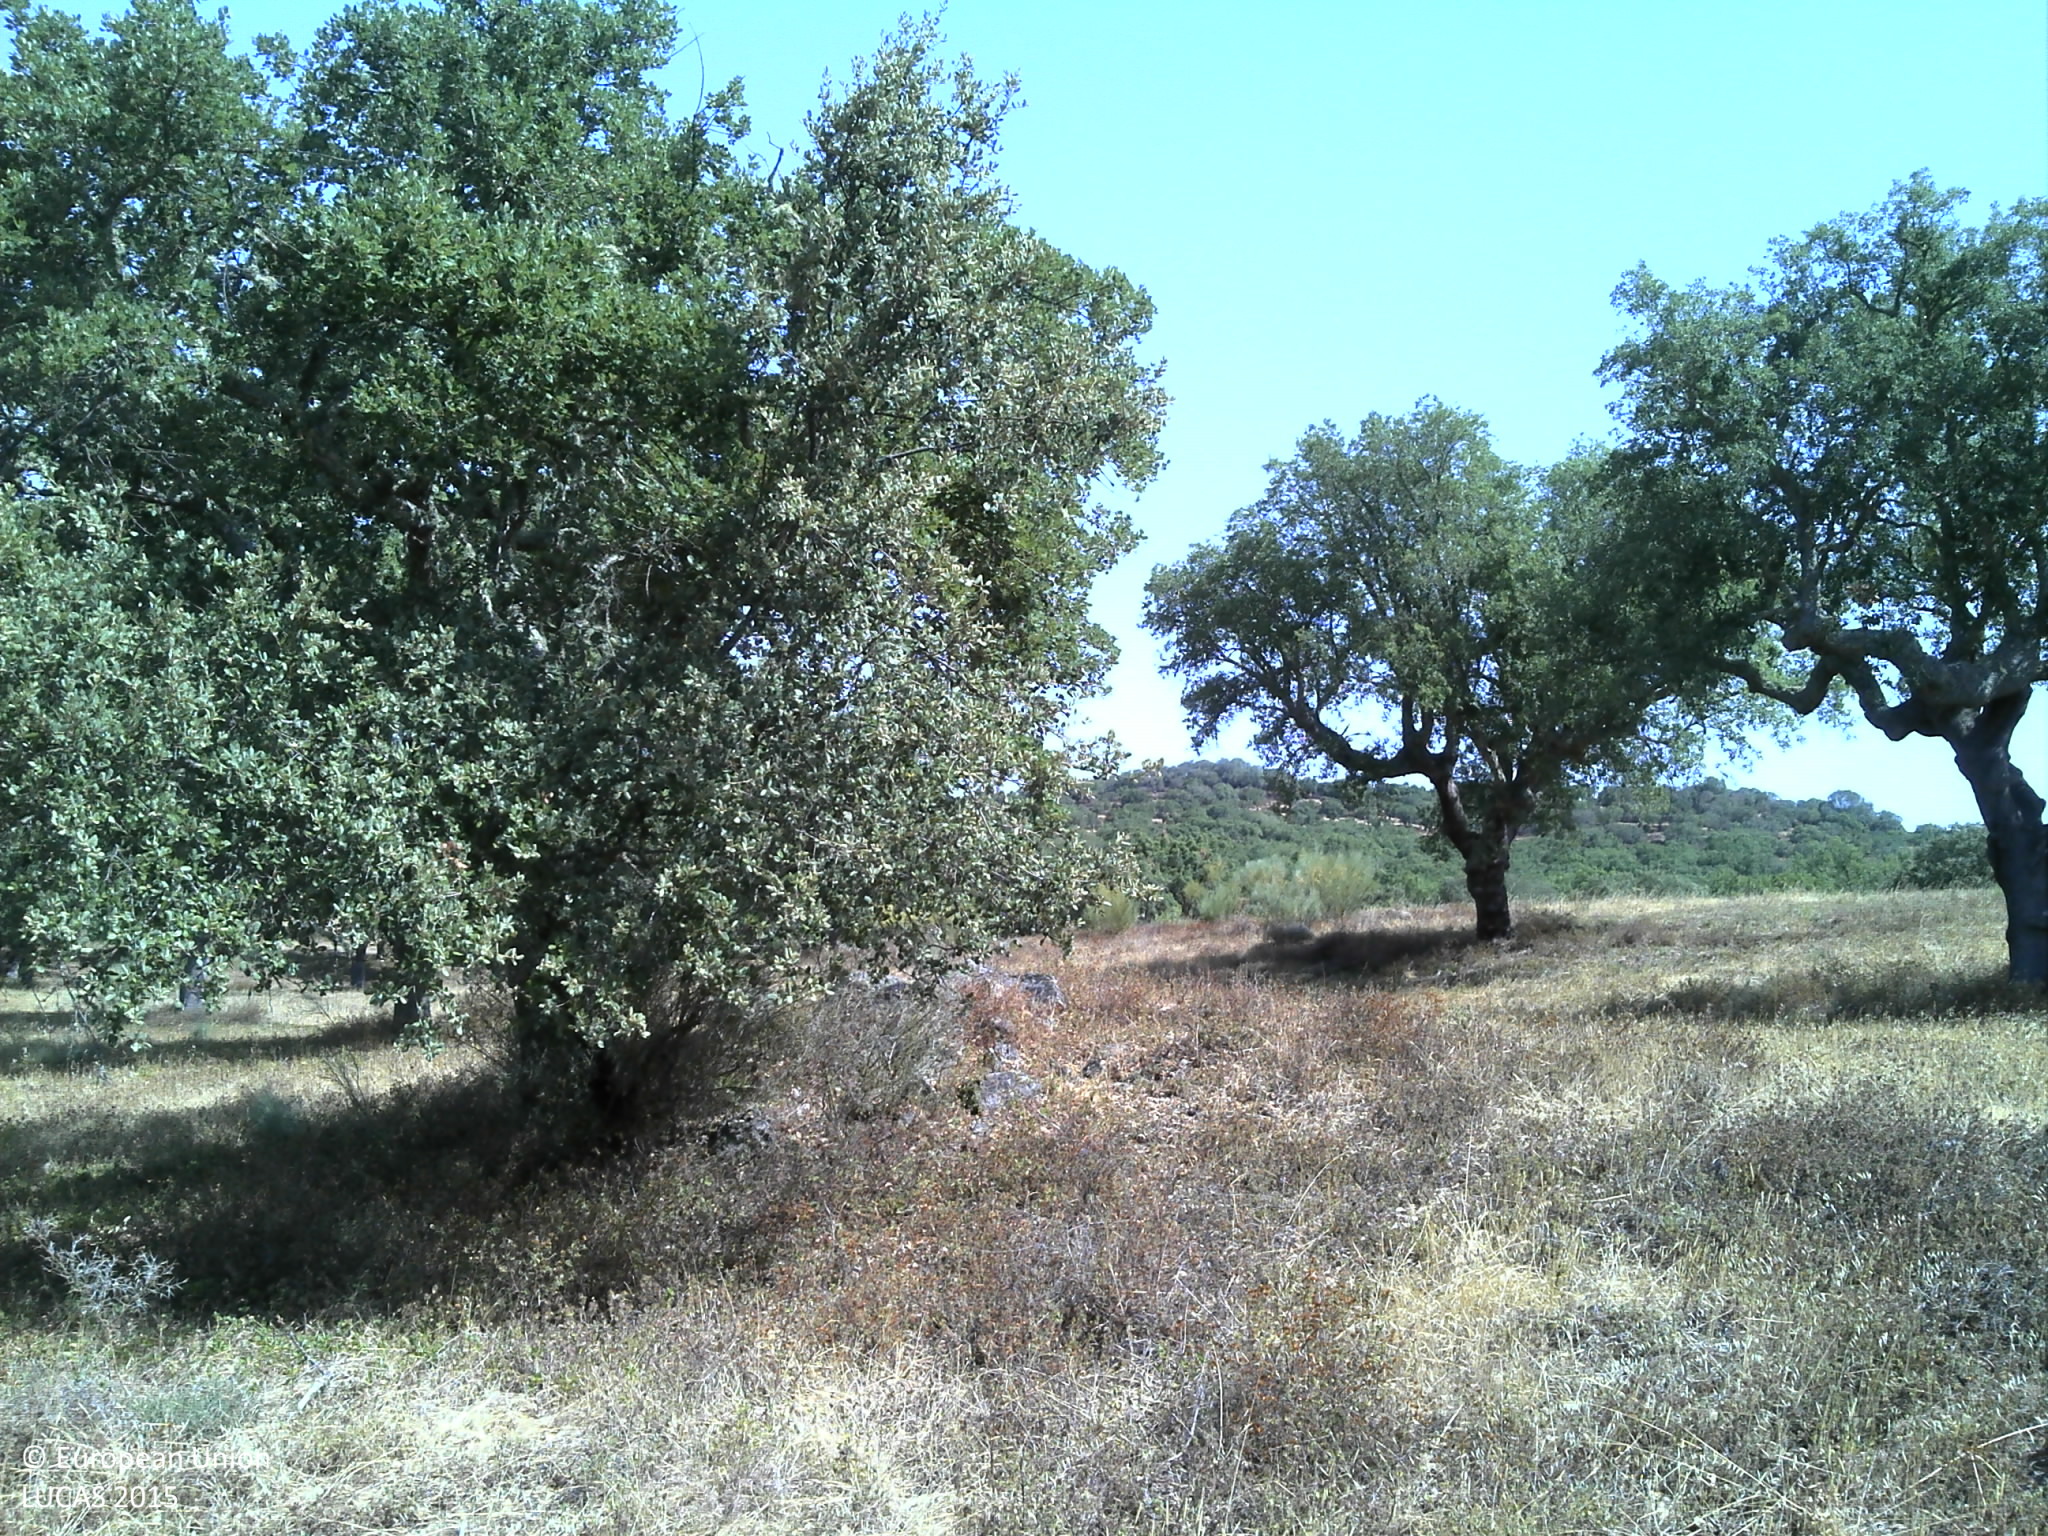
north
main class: Woodland
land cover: Broadleaved woodland
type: broadleaved evergreen forest
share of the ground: 10 - 25 %
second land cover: Grassland without tree/shrub cover
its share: 10 - 25 %
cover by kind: unconsolidated bare surface 70 %, broadleaved forest trees 15 %, herbaceous plants 15 %
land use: Forestry
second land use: Agriculture (excluding fallow land and kitchen gardens)
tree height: > 5 m
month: July
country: PT
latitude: 38.7247
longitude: -7.8582
